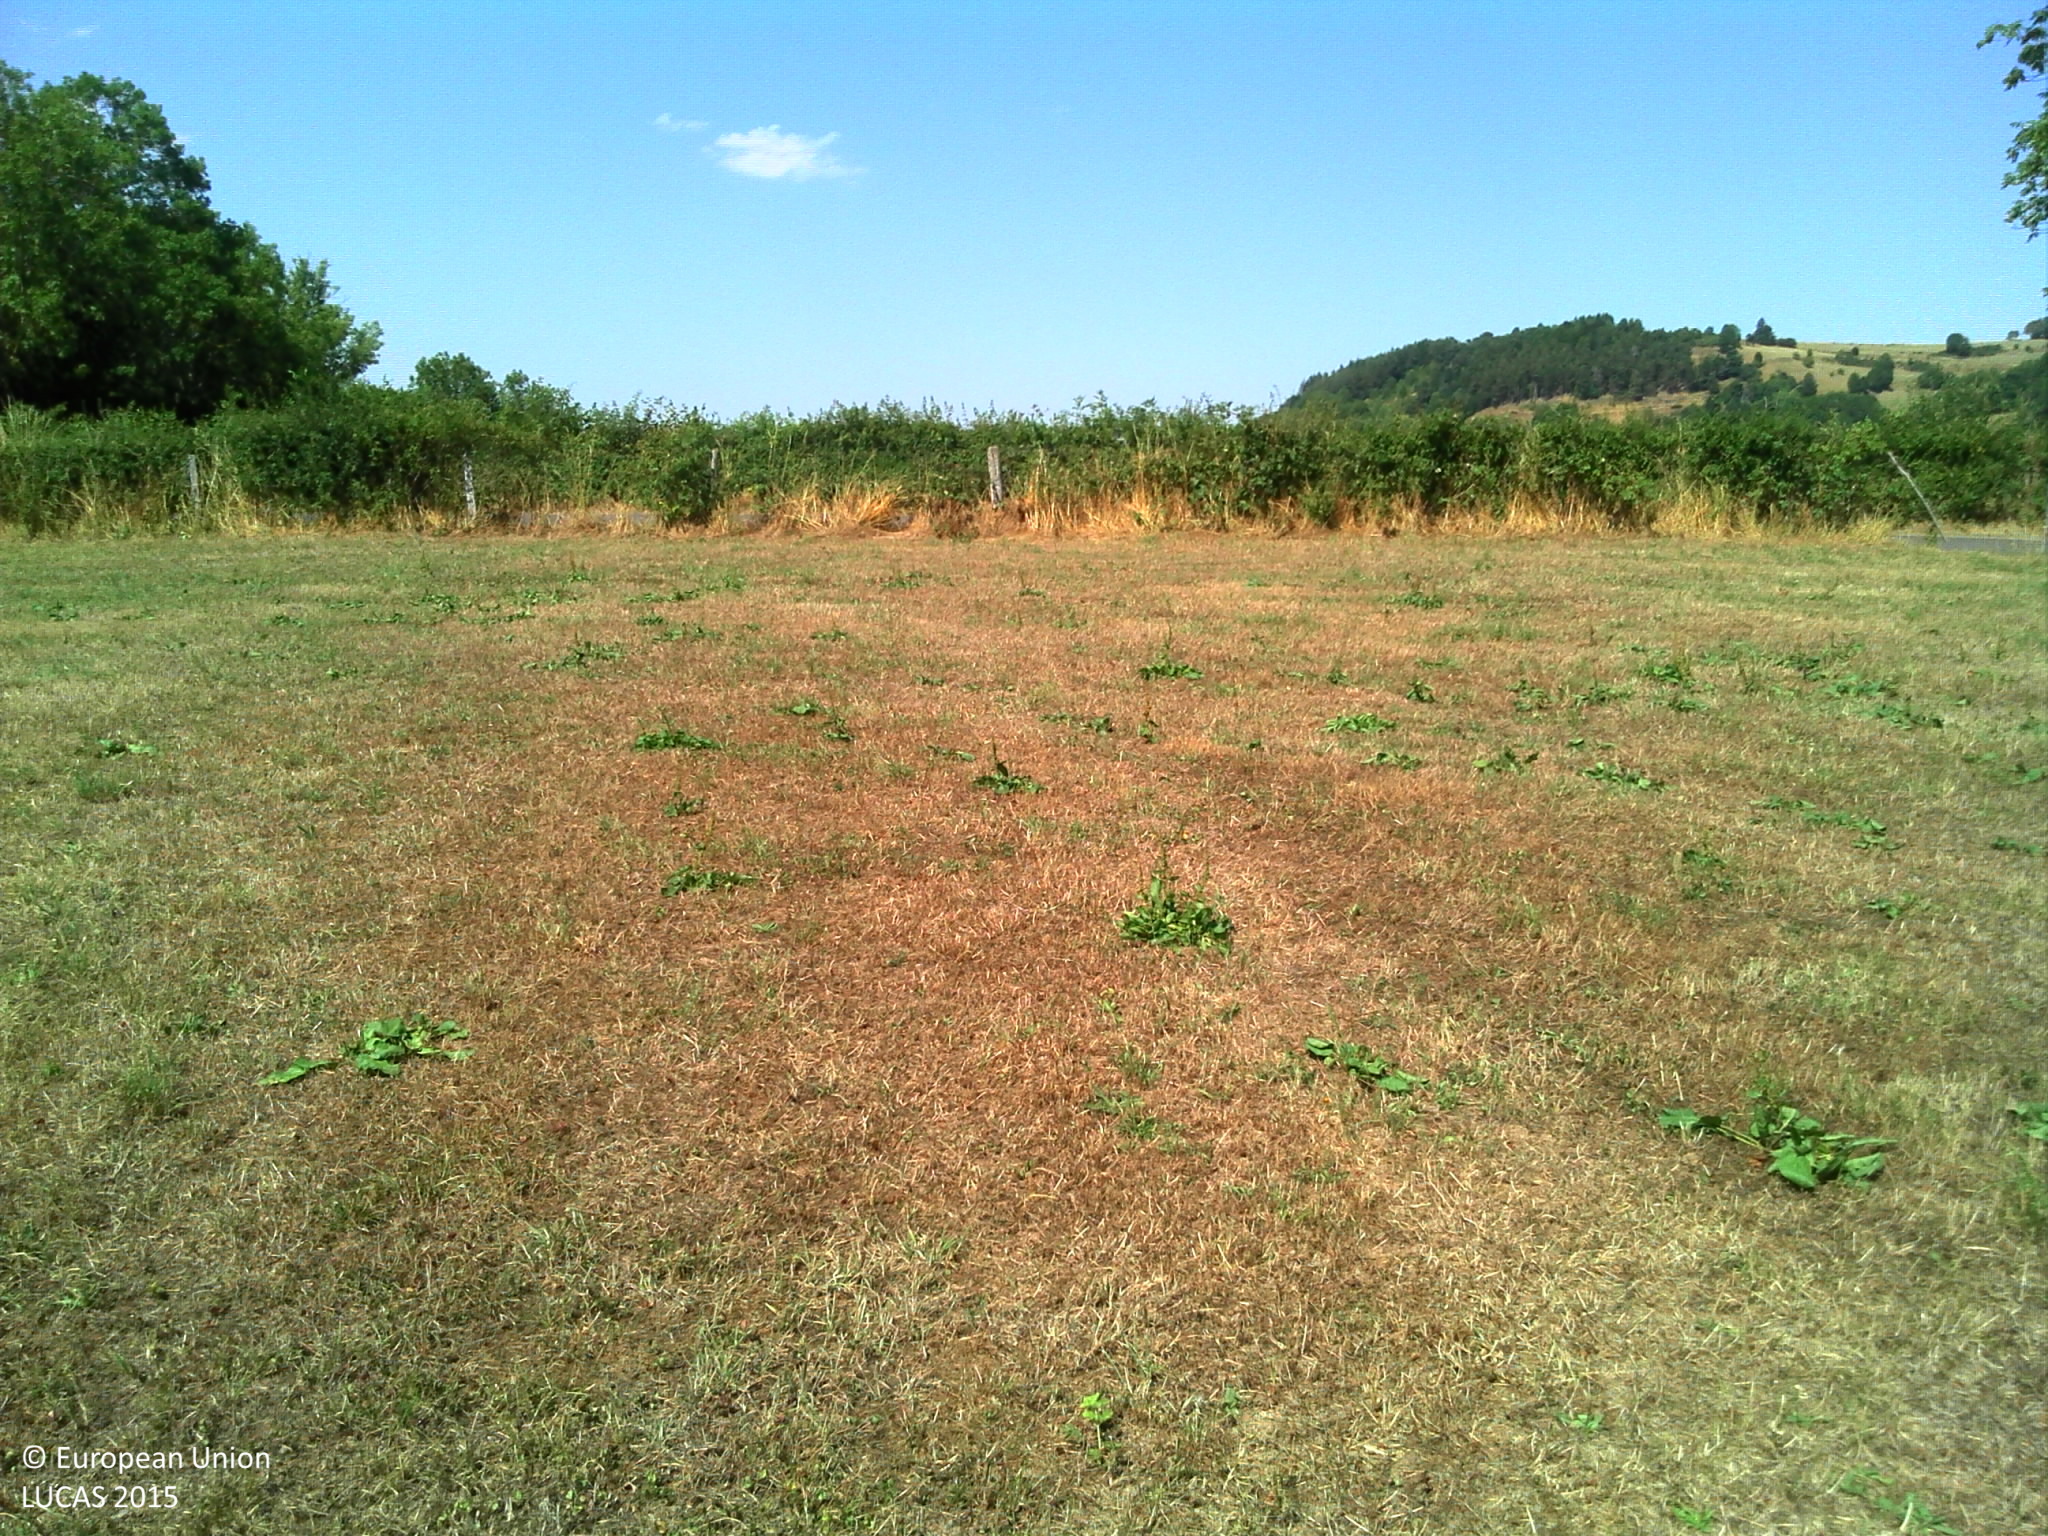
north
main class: Grassland
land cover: Grassland without tree/shrub cover
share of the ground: > 75 %
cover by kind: herbaceous plants 100 %
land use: Agriculture (excluding fallow land and kitchen gardens)
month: August
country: FR
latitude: 45.7136
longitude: 2.8437
